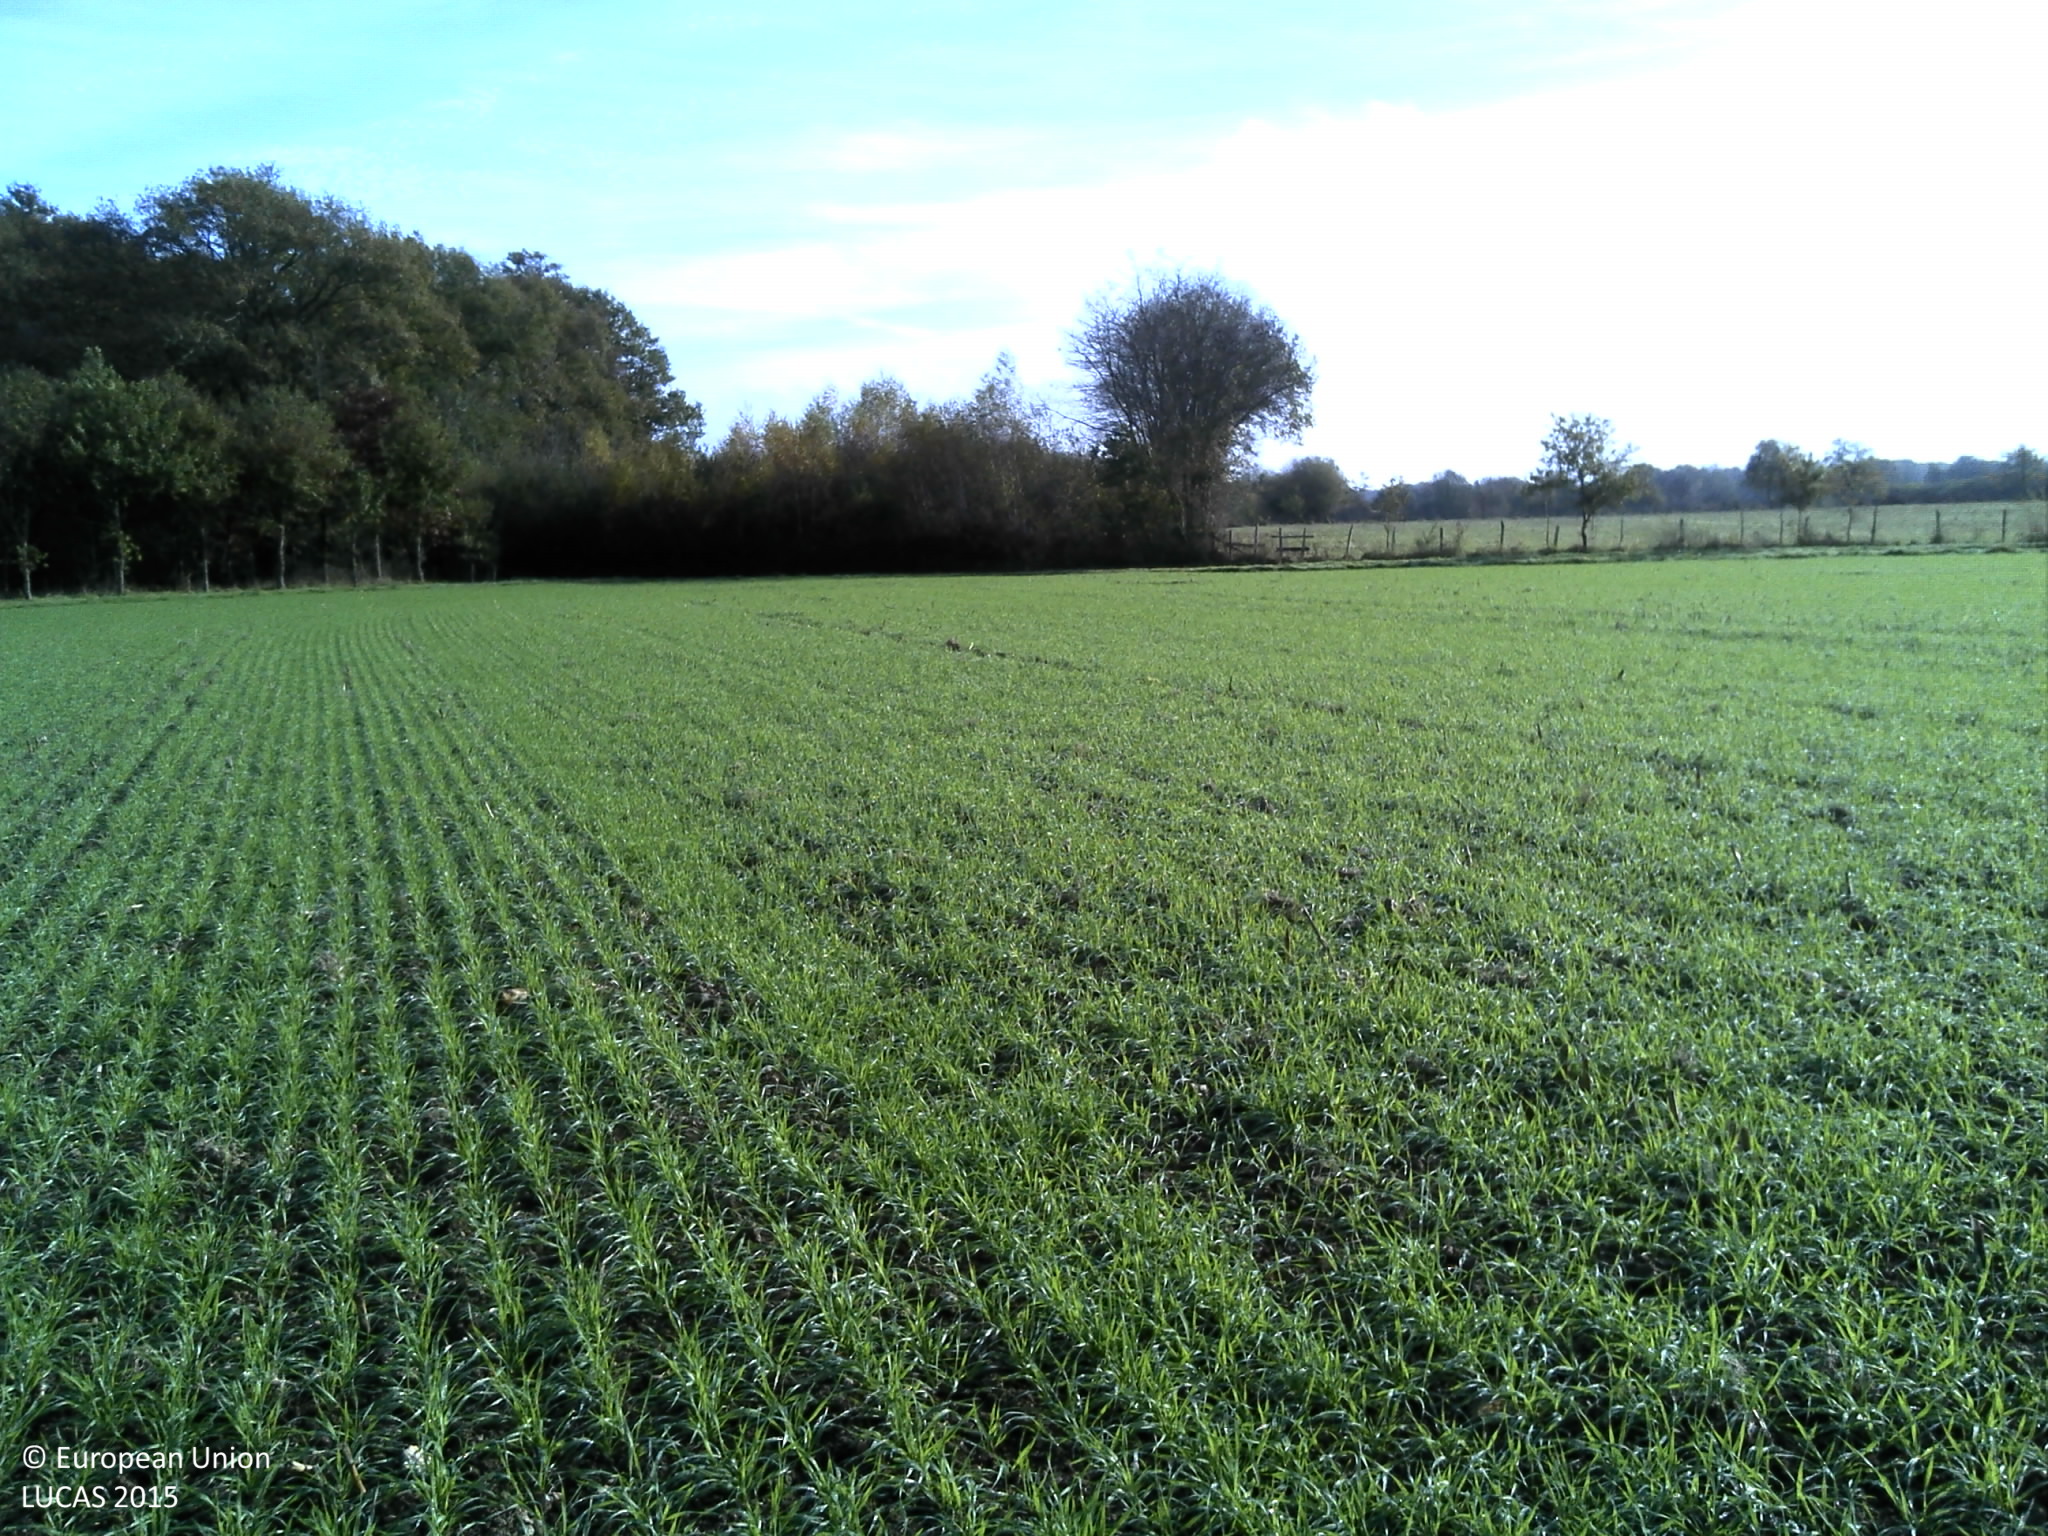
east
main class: Cropland
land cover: Temporary grasslands
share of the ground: > 75 %
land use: Agriculture (excluding fallow land and kitchen gardens)
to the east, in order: Temporary grasslands; Grassland without tree/shrub cover; Broadleaved woodland; Fences; Grassland without tree/shrub cover
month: November
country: FR
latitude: 47.3933
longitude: -1.7439
